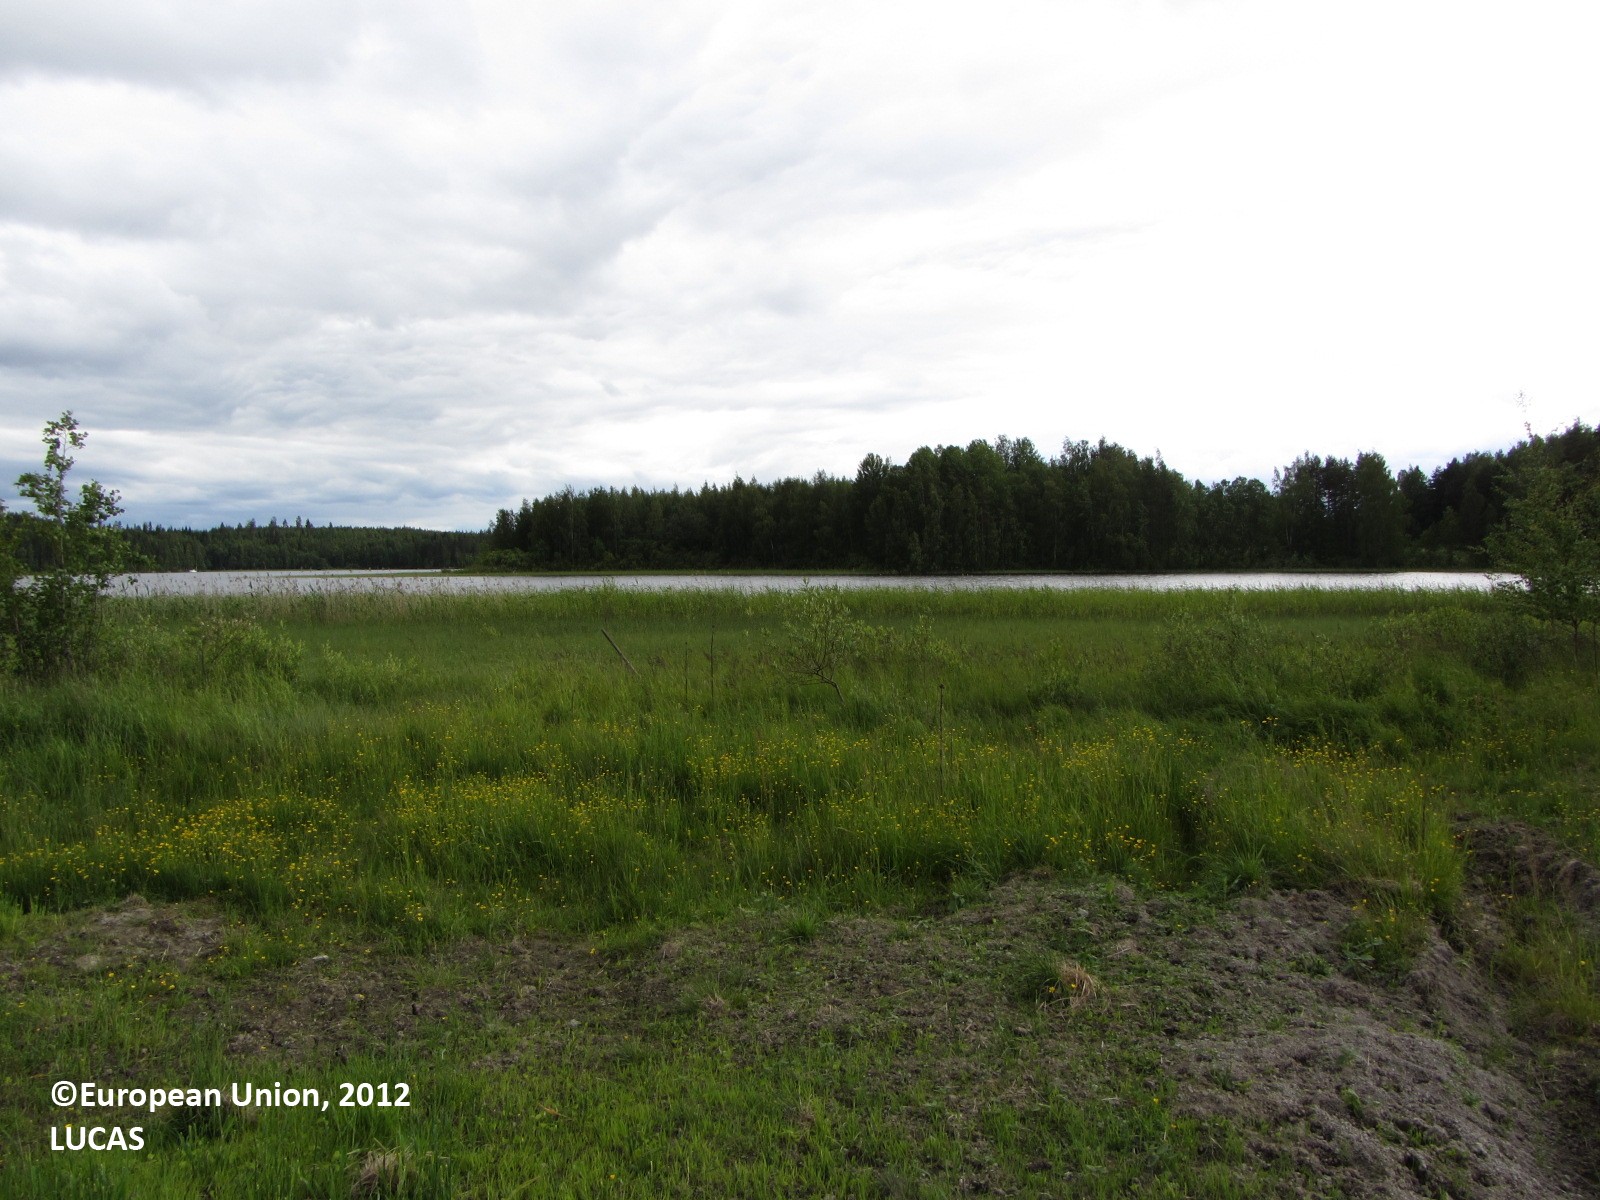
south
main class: Grassland
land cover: Grassland without tree/shrub cover
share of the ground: > 75 %
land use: Agriculture (excluding fallow land and kitchen gardens)
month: June
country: FI
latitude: 62.7595
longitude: 25.5214
